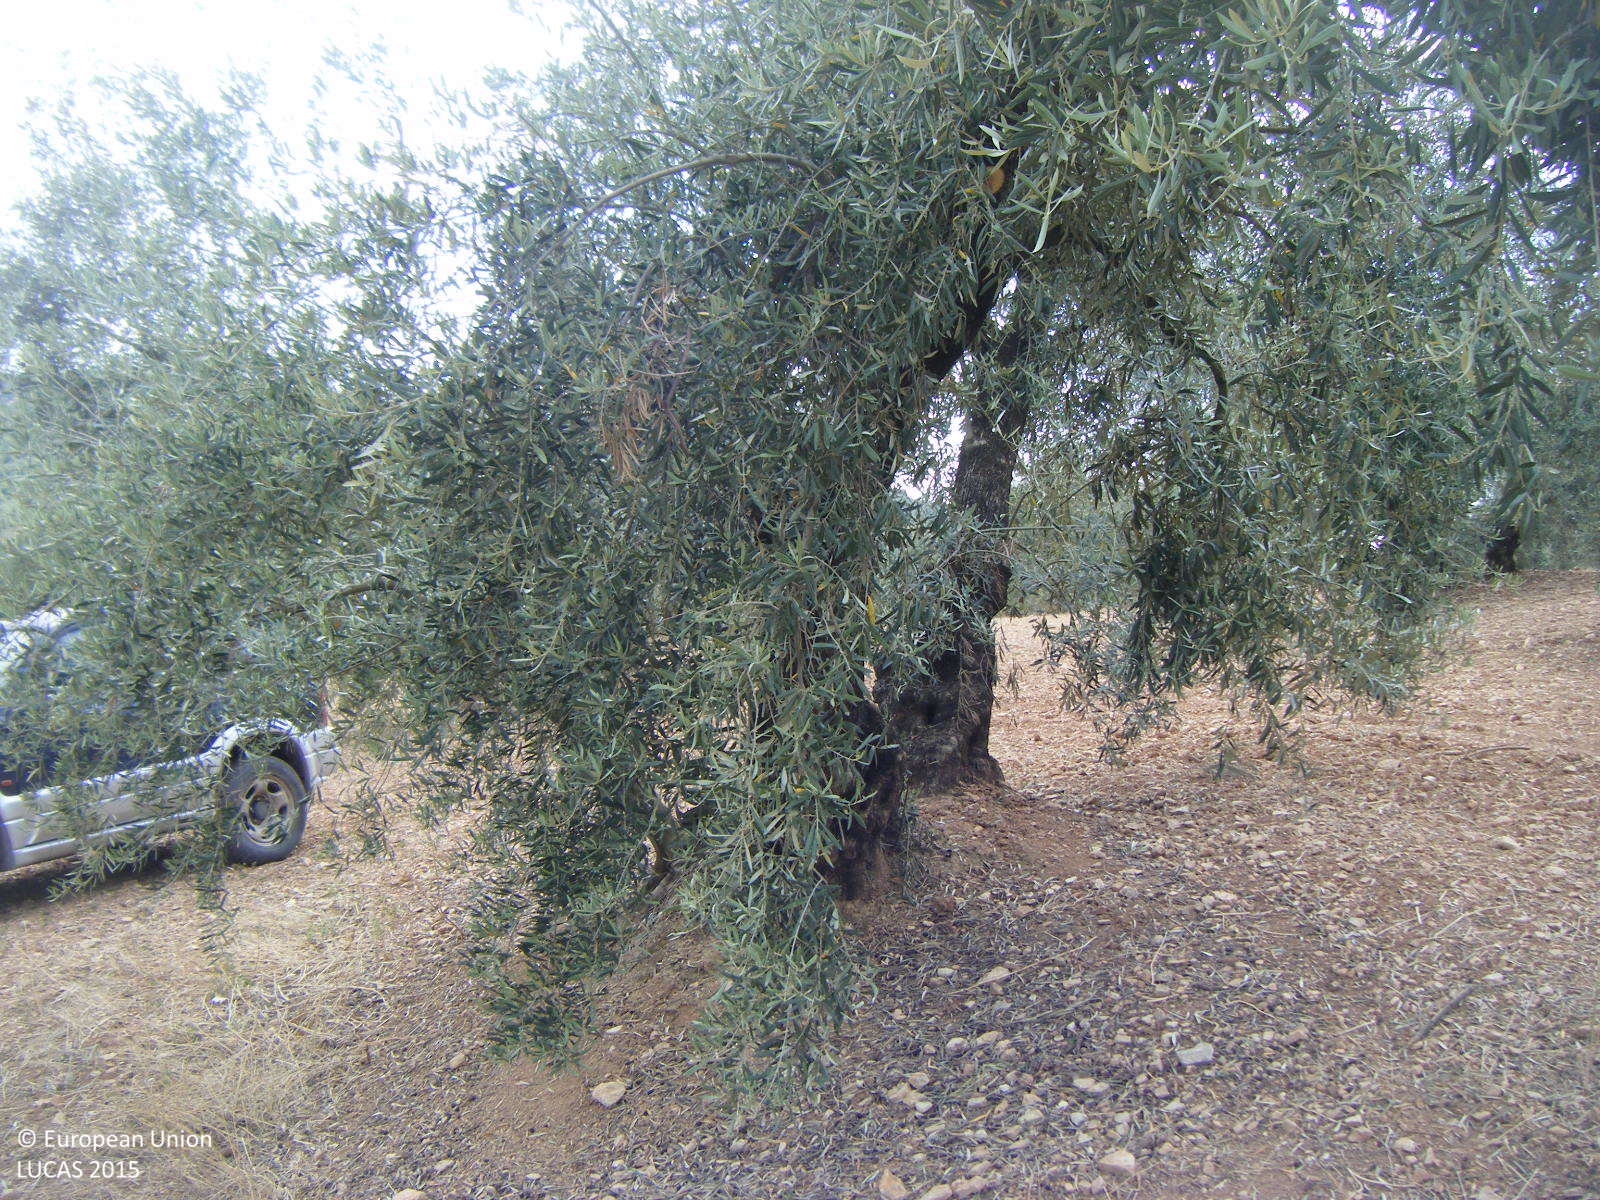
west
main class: Cropland
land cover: Olive groves
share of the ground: 25 - 50 %
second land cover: Other bare soil
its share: > 75 %
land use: Agriculture (excluding fallow land and kitchen gardens)
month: May
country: ES
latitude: 37.1924
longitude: -4.4293
